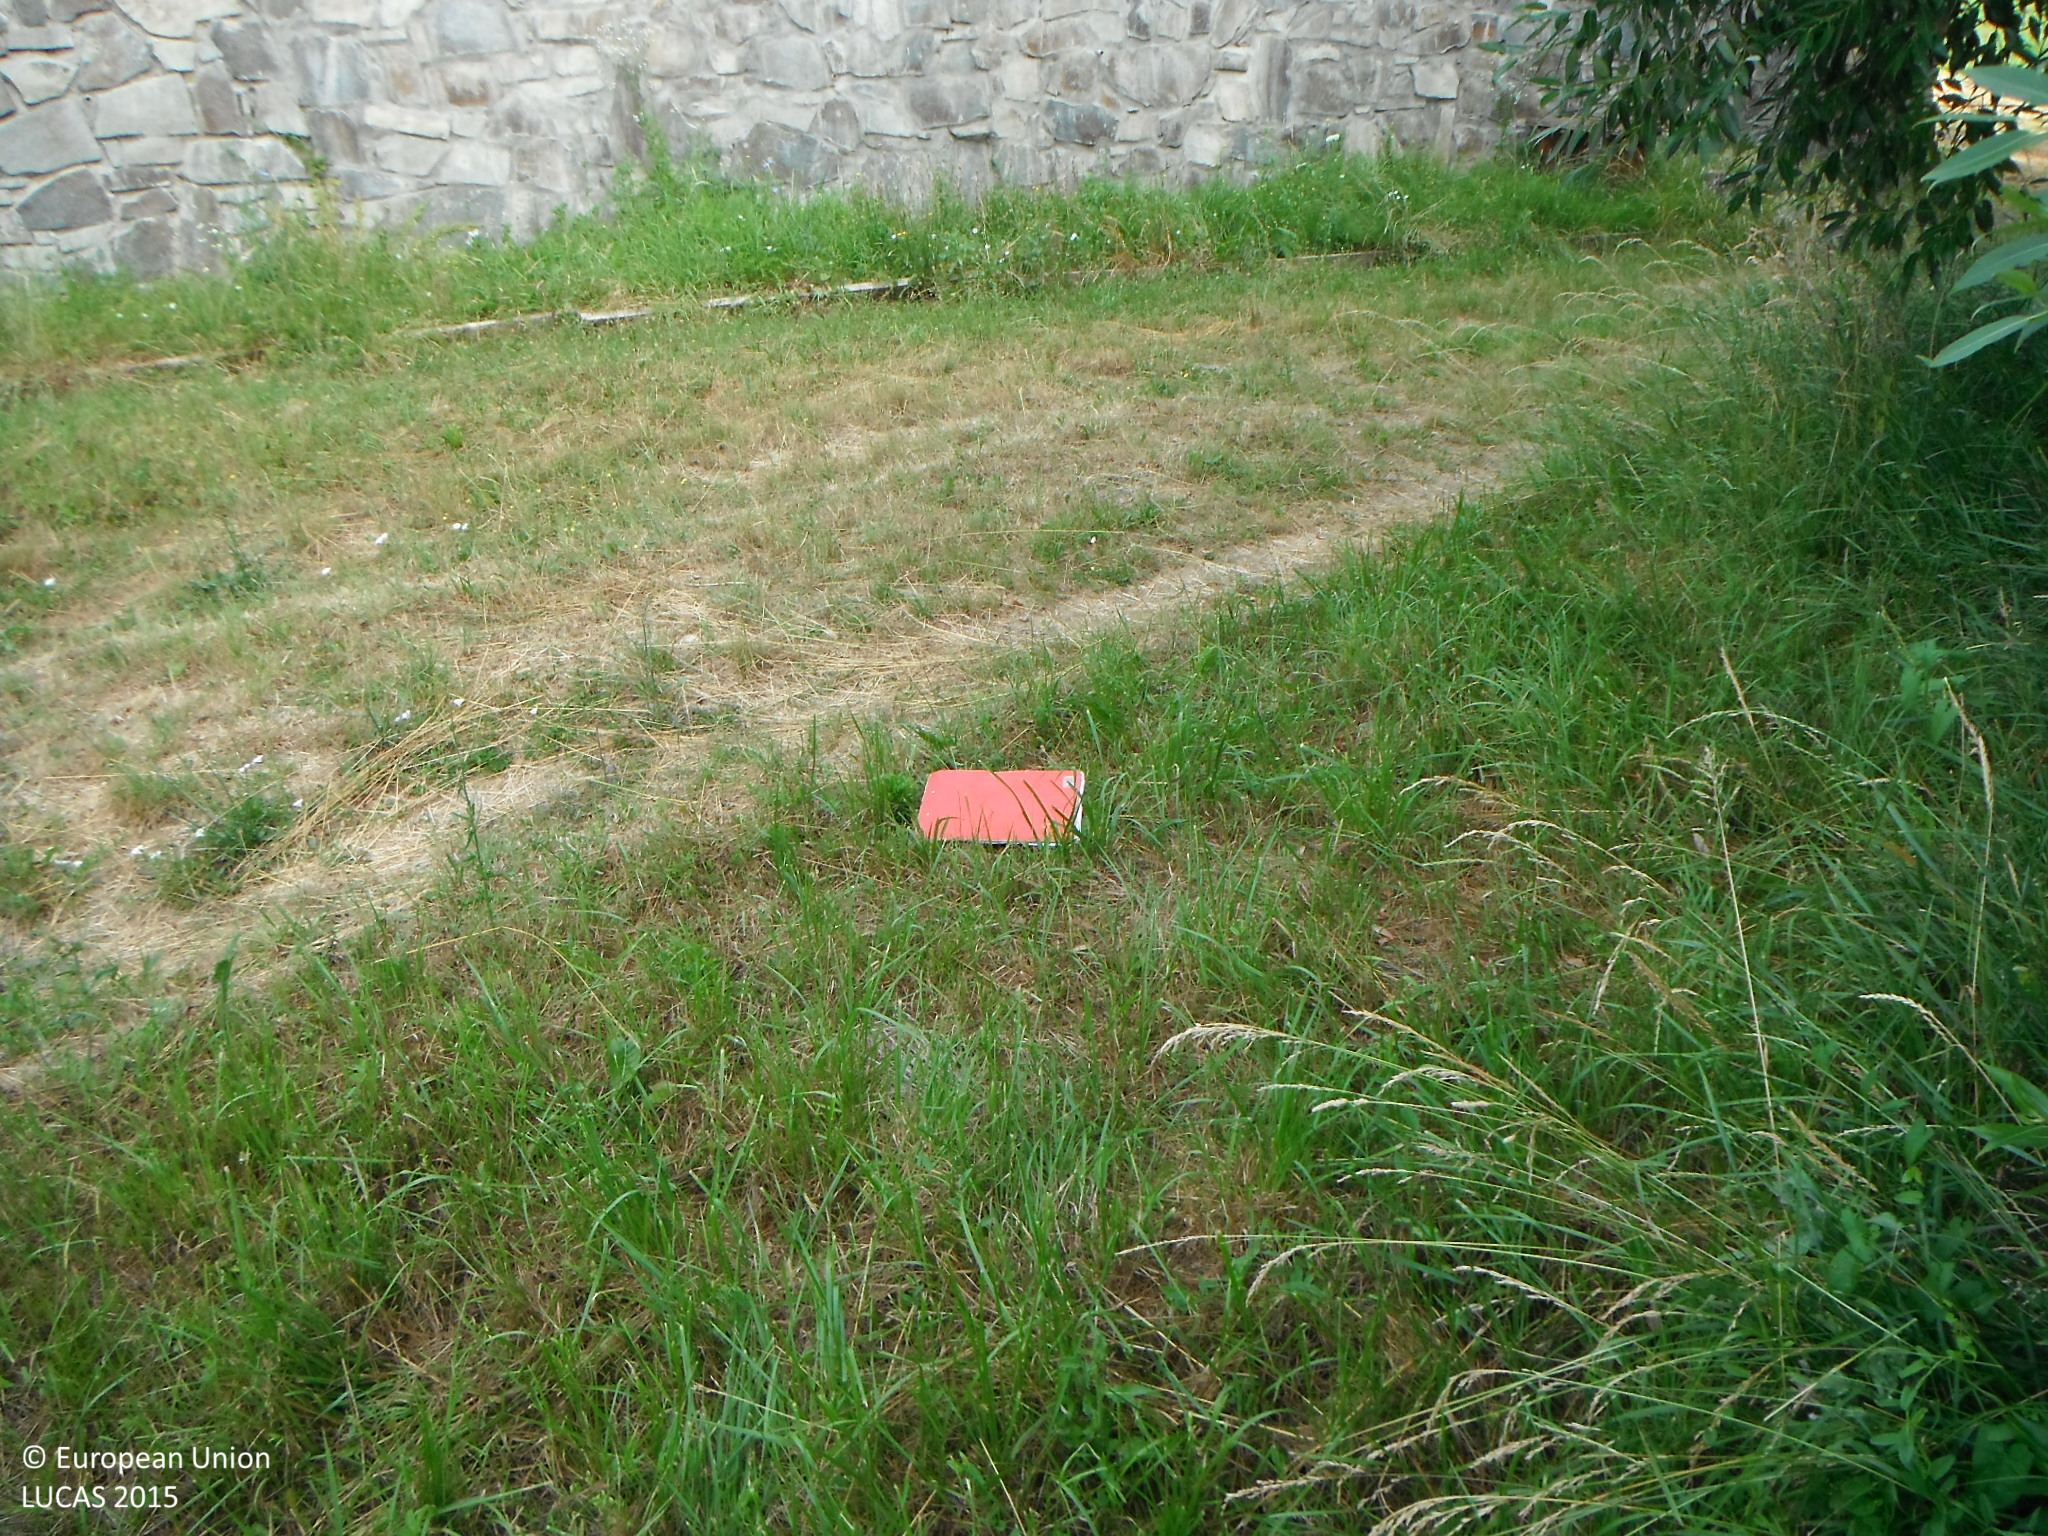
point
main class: Grassland
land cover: Grassland without tree/shrub cover
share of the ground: > 75 %
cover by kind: herbaceous plants 100 %
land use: Agriculture (excluding fallow land and kitchen gardens)
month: July
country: SK
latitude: 48.5851
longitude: 19.1455
